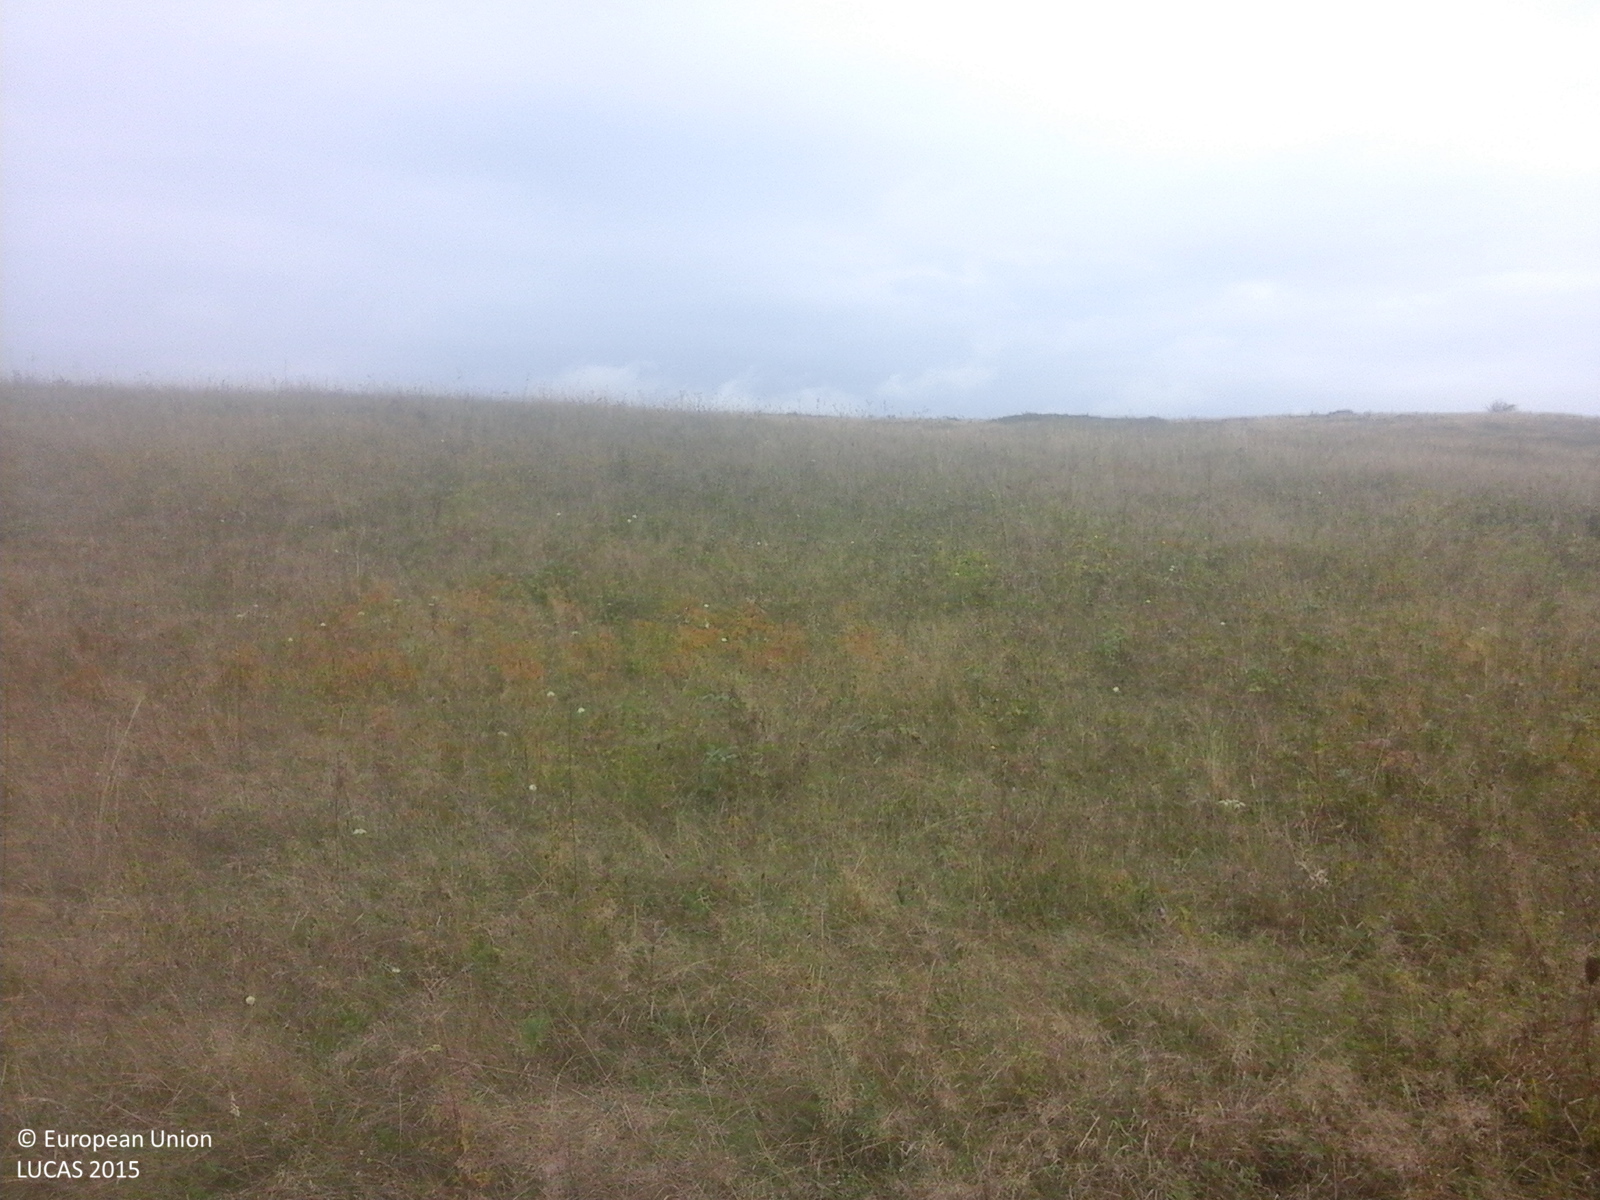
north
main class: Grassland
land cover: Grassland without tree/shrub cover
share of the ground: > 75 %
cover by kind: herbaceous plants 100 %
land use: Agriculture (excluding fallow land and kitchen gardens)
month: September
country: RO
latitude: 45.8663
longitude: 22.0599
